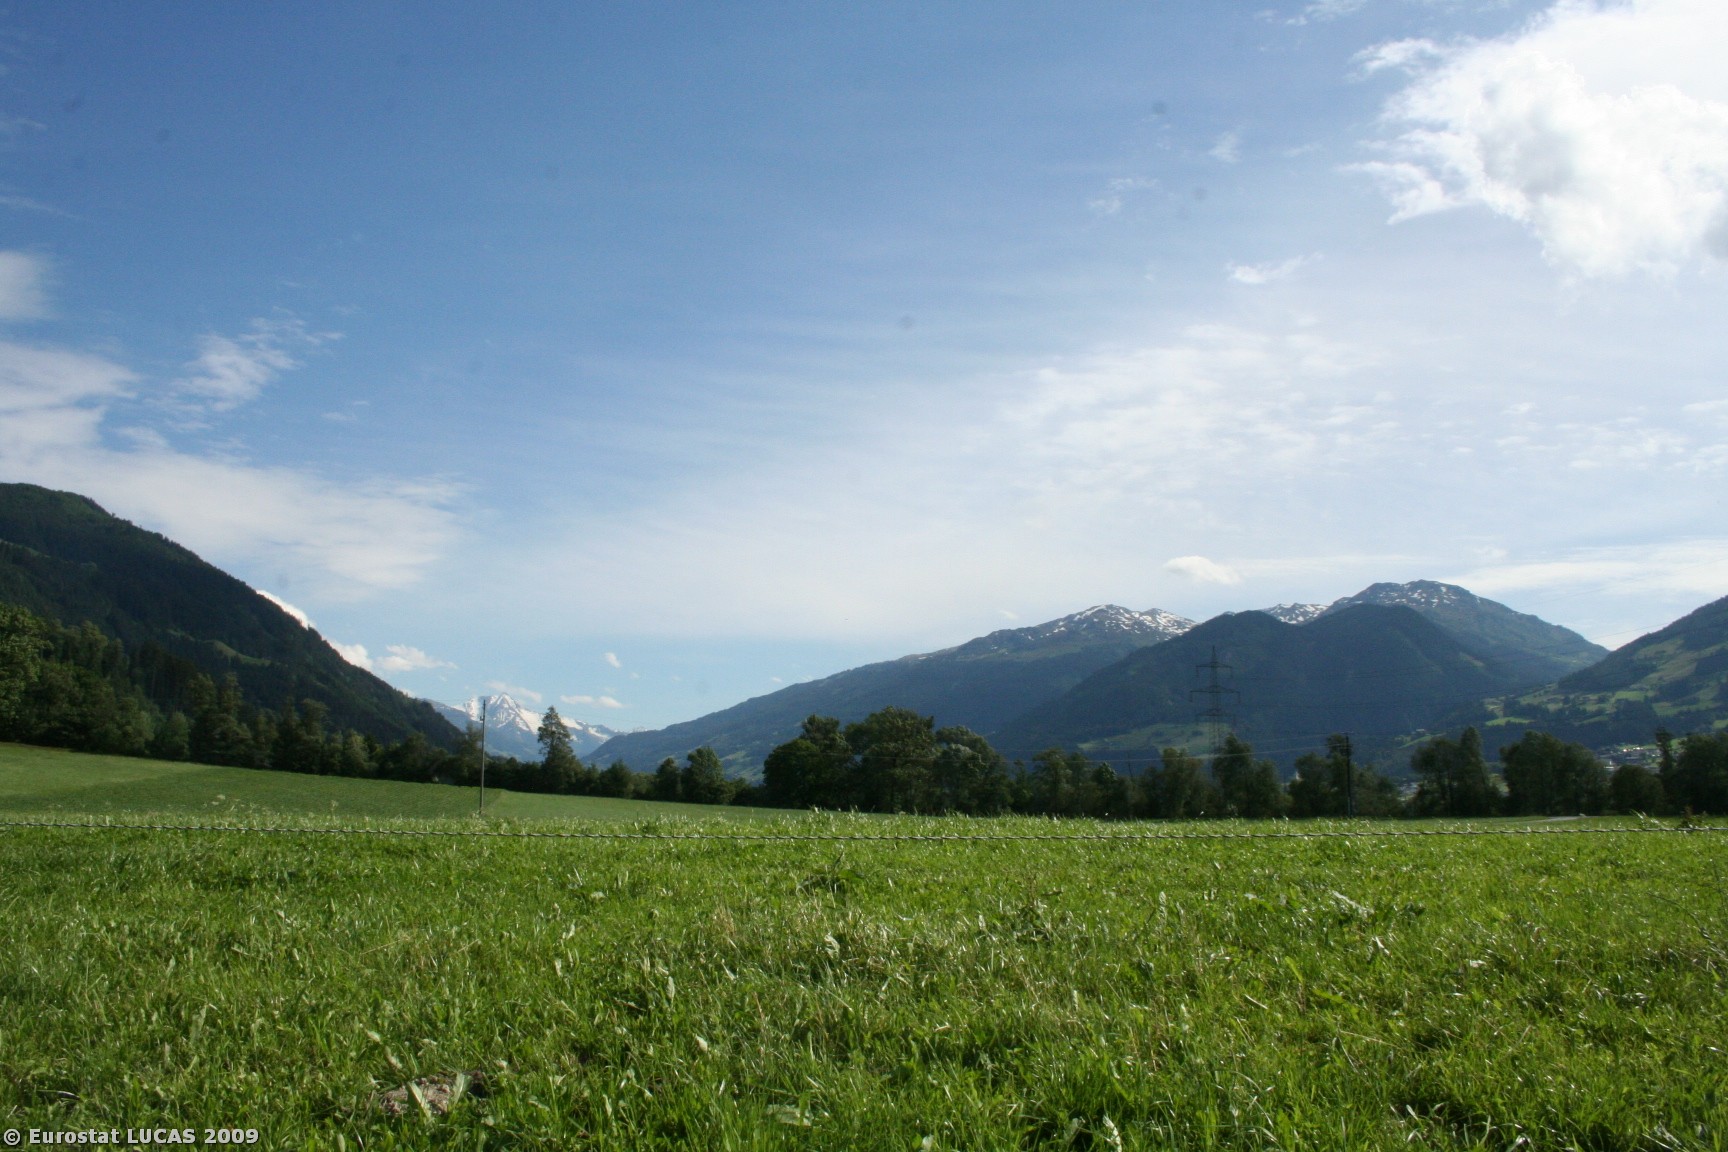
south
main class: Grassland
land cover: Grassland without tree/shrub cover
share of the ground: > 75 %
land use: Agriculture (excluding fallow land and kitchen gardens)
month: June
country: AT
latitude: 47.3616
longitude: 11.8654
